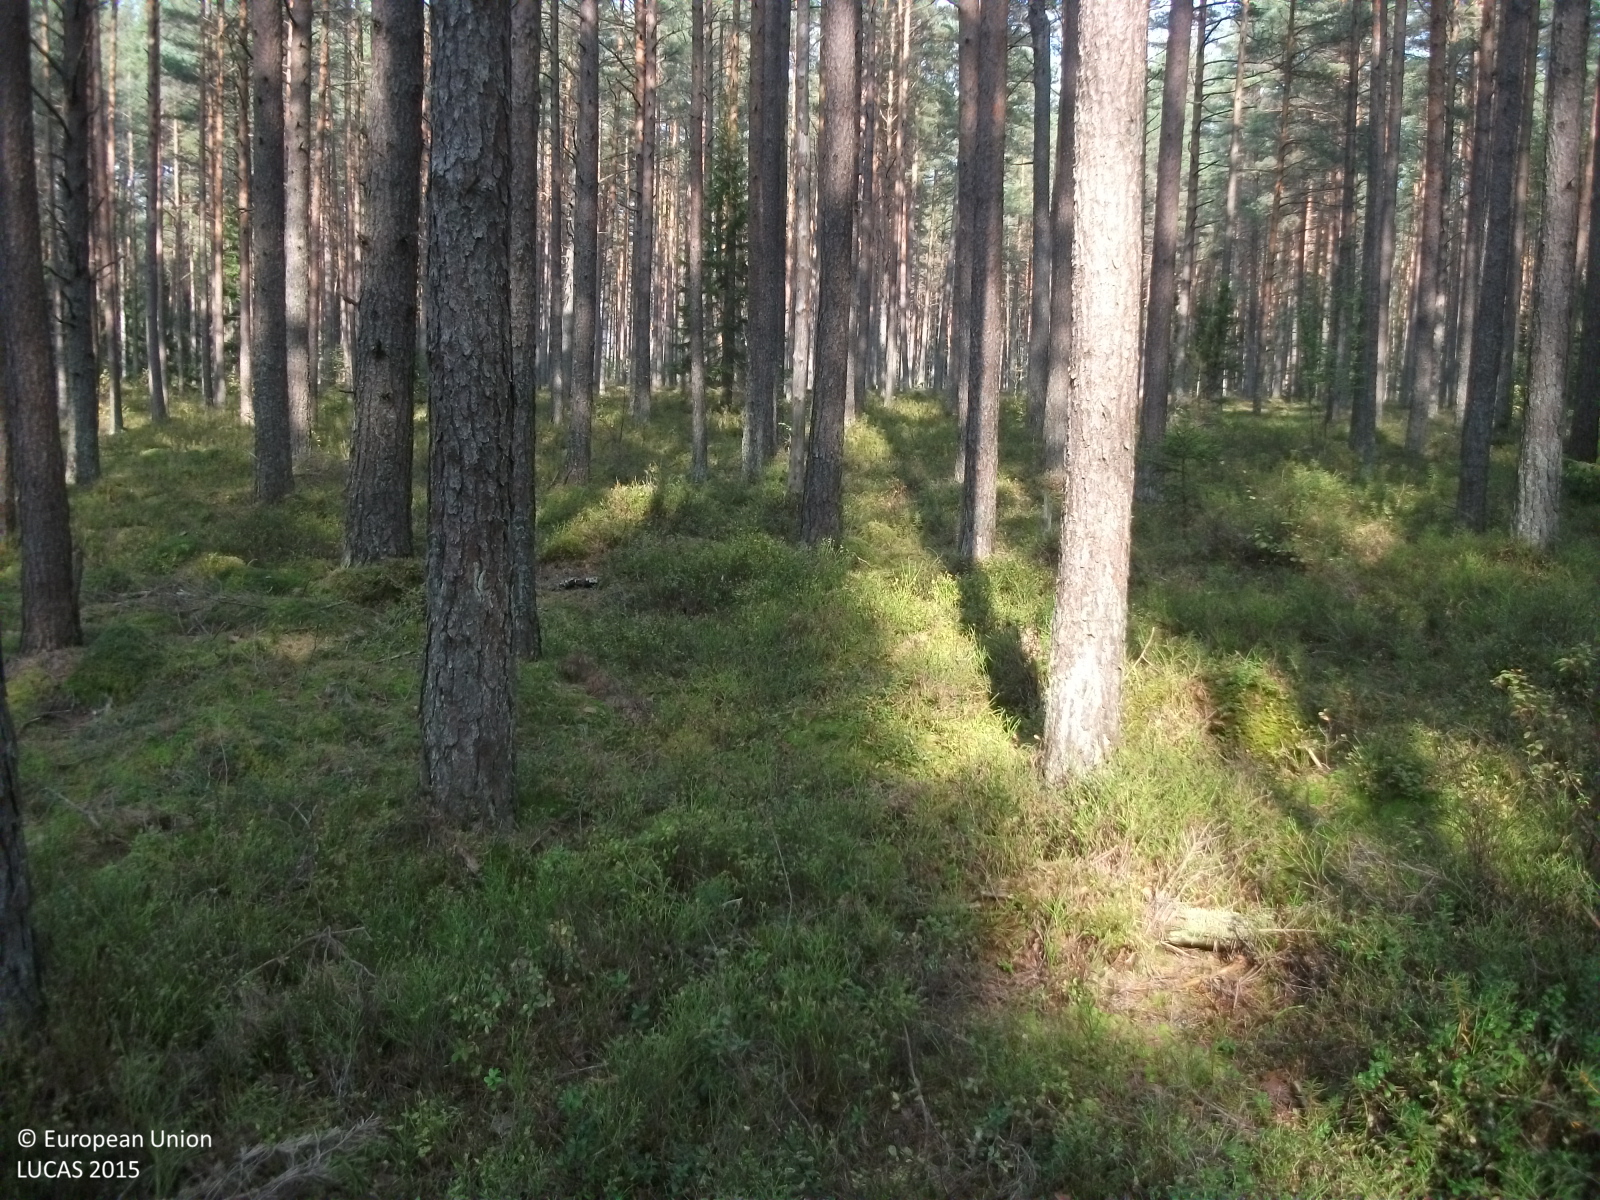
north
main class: Woodland
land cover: Pine dominated coniferous woodland
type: hemiboreal forest and nemoral coniferous forest and mixed broadleaved-coniferous forest
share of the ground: > 75 %
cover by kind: coniferous forest trees 85 %, lichens and mosses 15 %
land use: Forestry
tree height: > 5 m
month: September
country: LV
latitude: 57.8316
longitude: 24.4873
